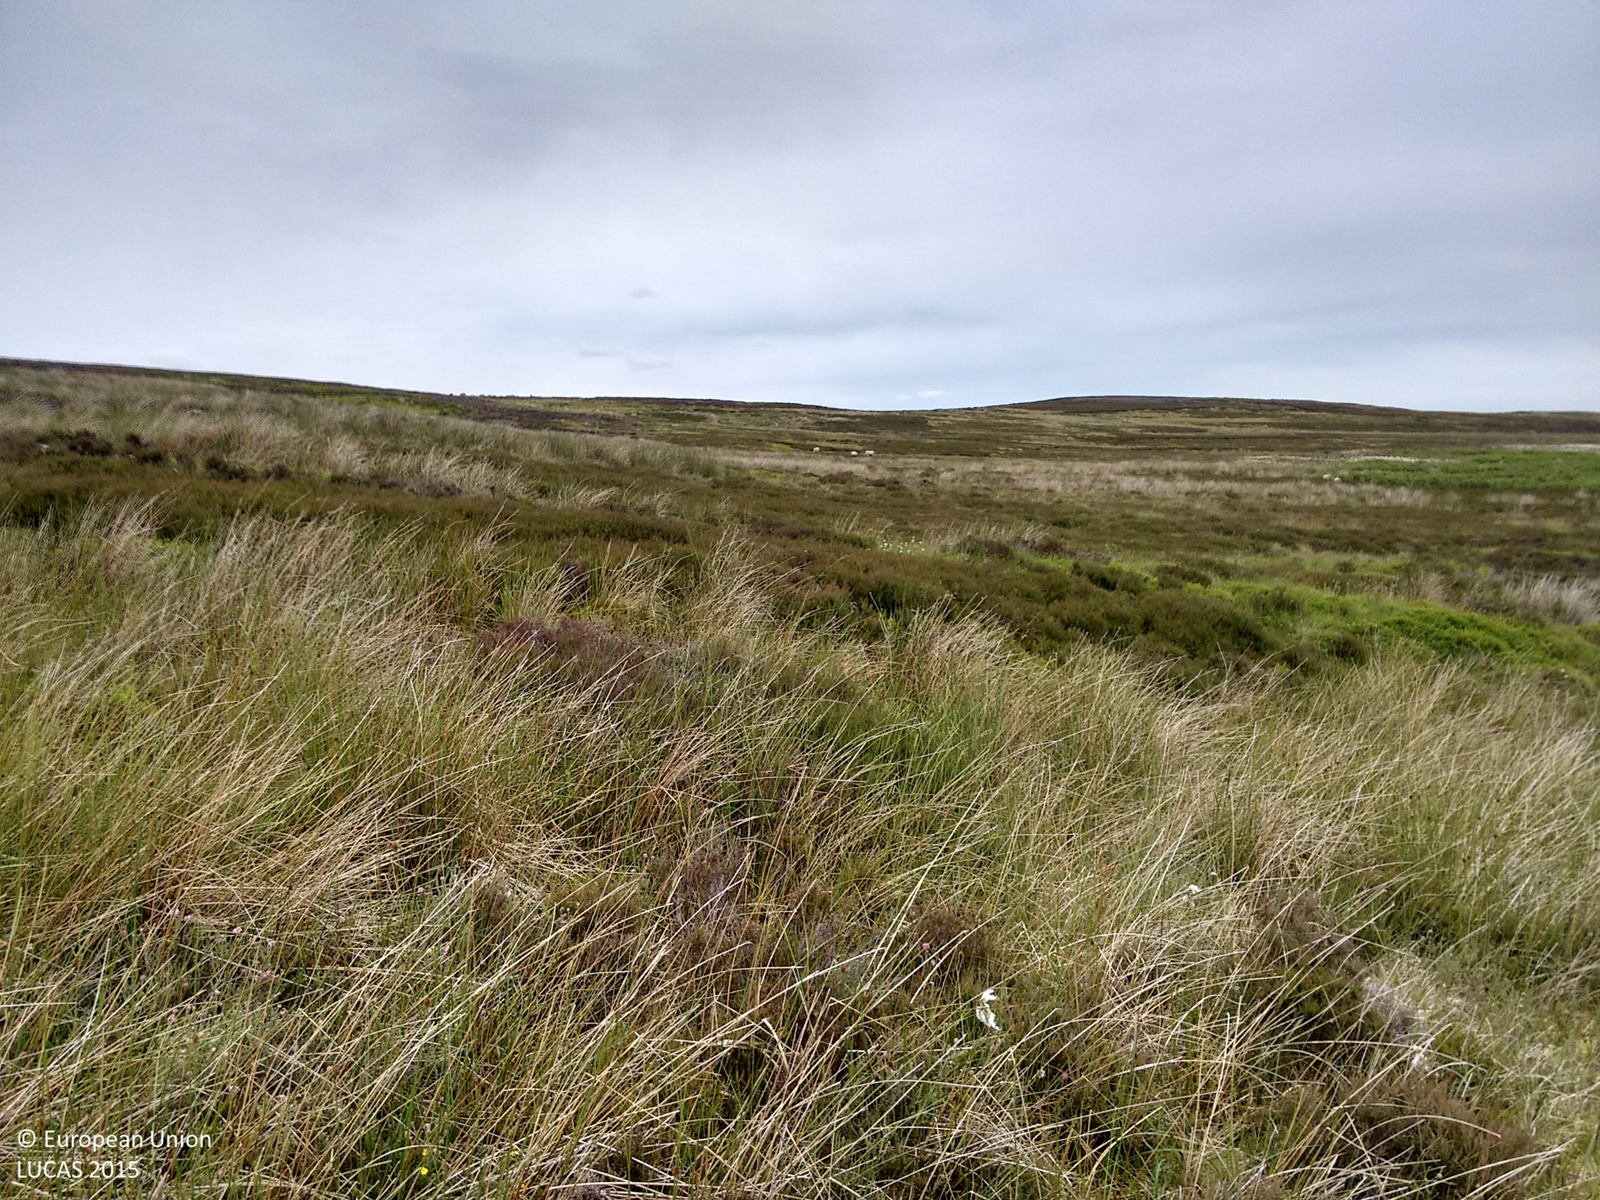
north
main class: Shrubland
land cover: Shrubland without tree cover
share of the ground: > 75 %
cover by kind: shrubs 65 %, herbaceous plants 35 %
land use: Agriculture (excluding fallow land and kitchen gardens)
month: July
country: GB
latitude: 54.4171
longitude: -0.8737
